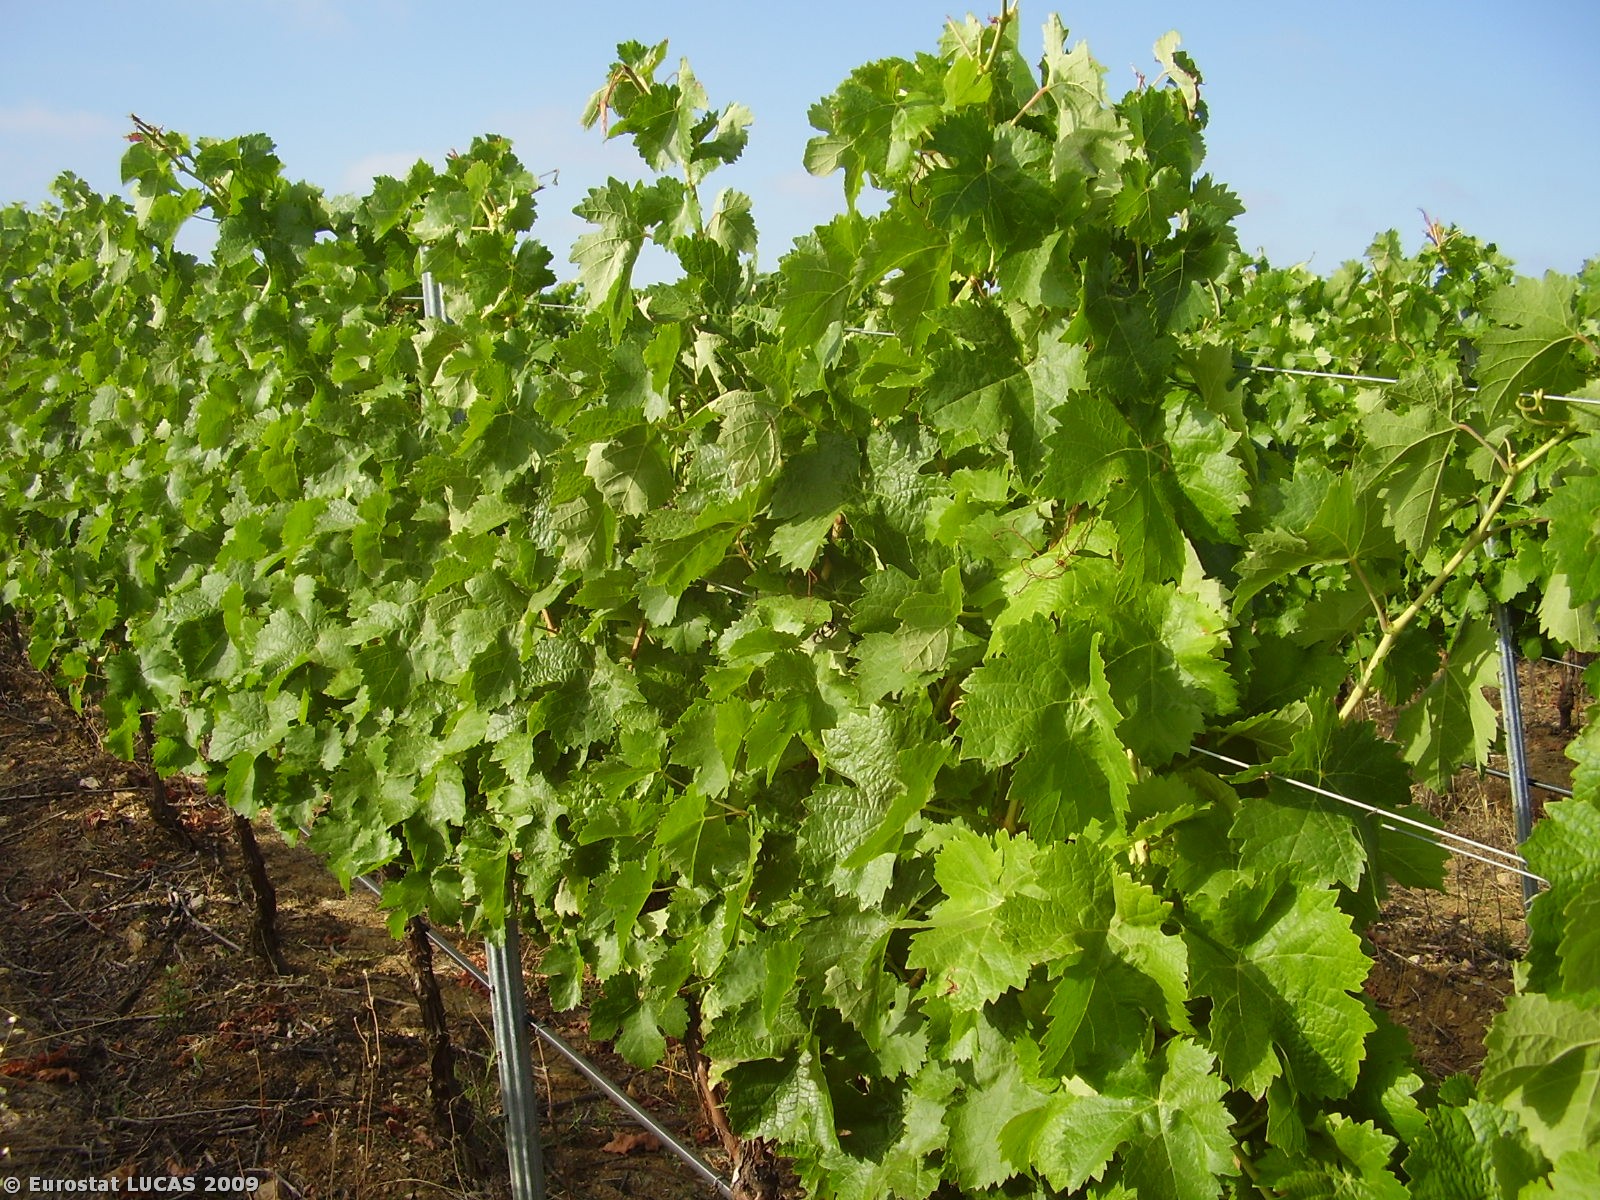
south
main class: Cropland
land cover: Vineyards
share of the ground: 25 - 50 %
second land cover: Spontaneously vegetated surfaces
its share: 50 - 75 %
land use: Agriculture (excluding fallow land and kitchen gardens)
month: July
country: PT
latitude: 38.7823
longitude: -7.9448
